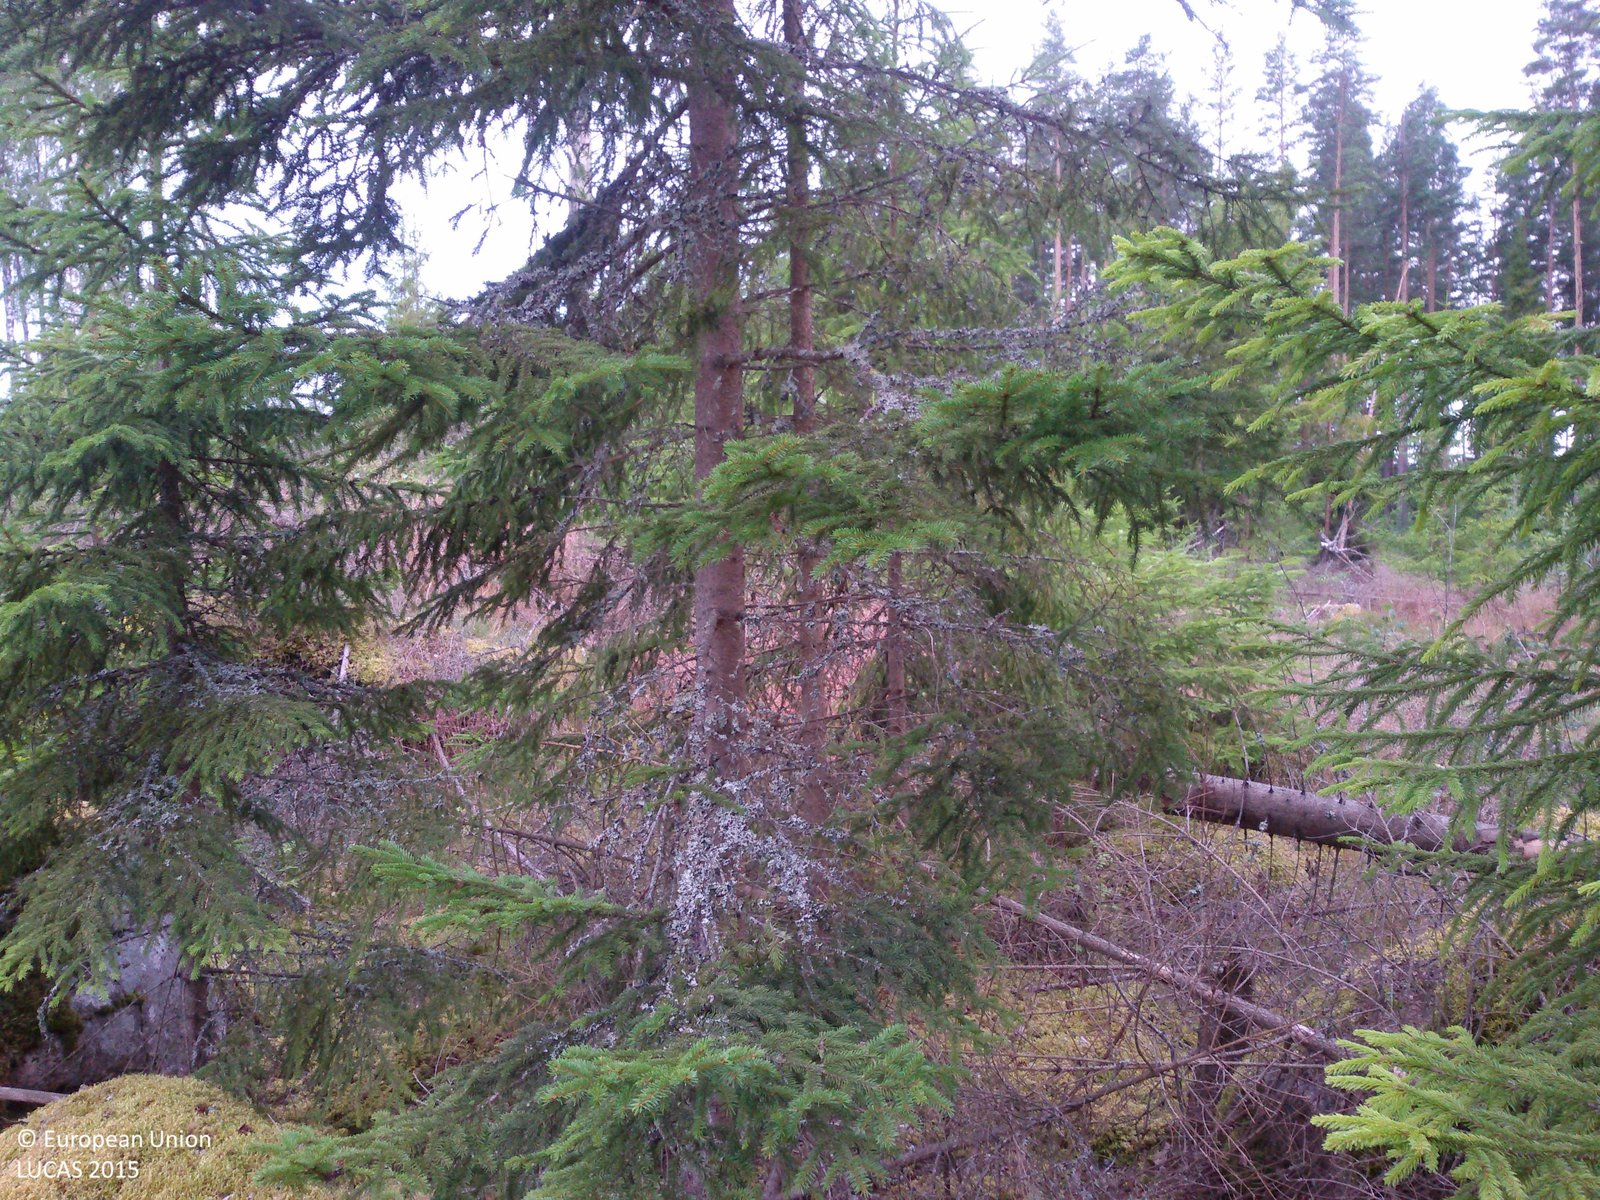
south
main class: Woodland
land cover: Spruce dominated mixed woodland
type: boreal forest
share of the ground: 50 - 75 %
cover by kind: coniferous forest trees 30 %, broadleaved forest trees 30 %, herbaceous plants 20 %, lichens and mosses 20 %
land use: Forestry
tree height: < 5 m
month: July
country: SE
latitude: 60.4383
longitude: 15.8573
